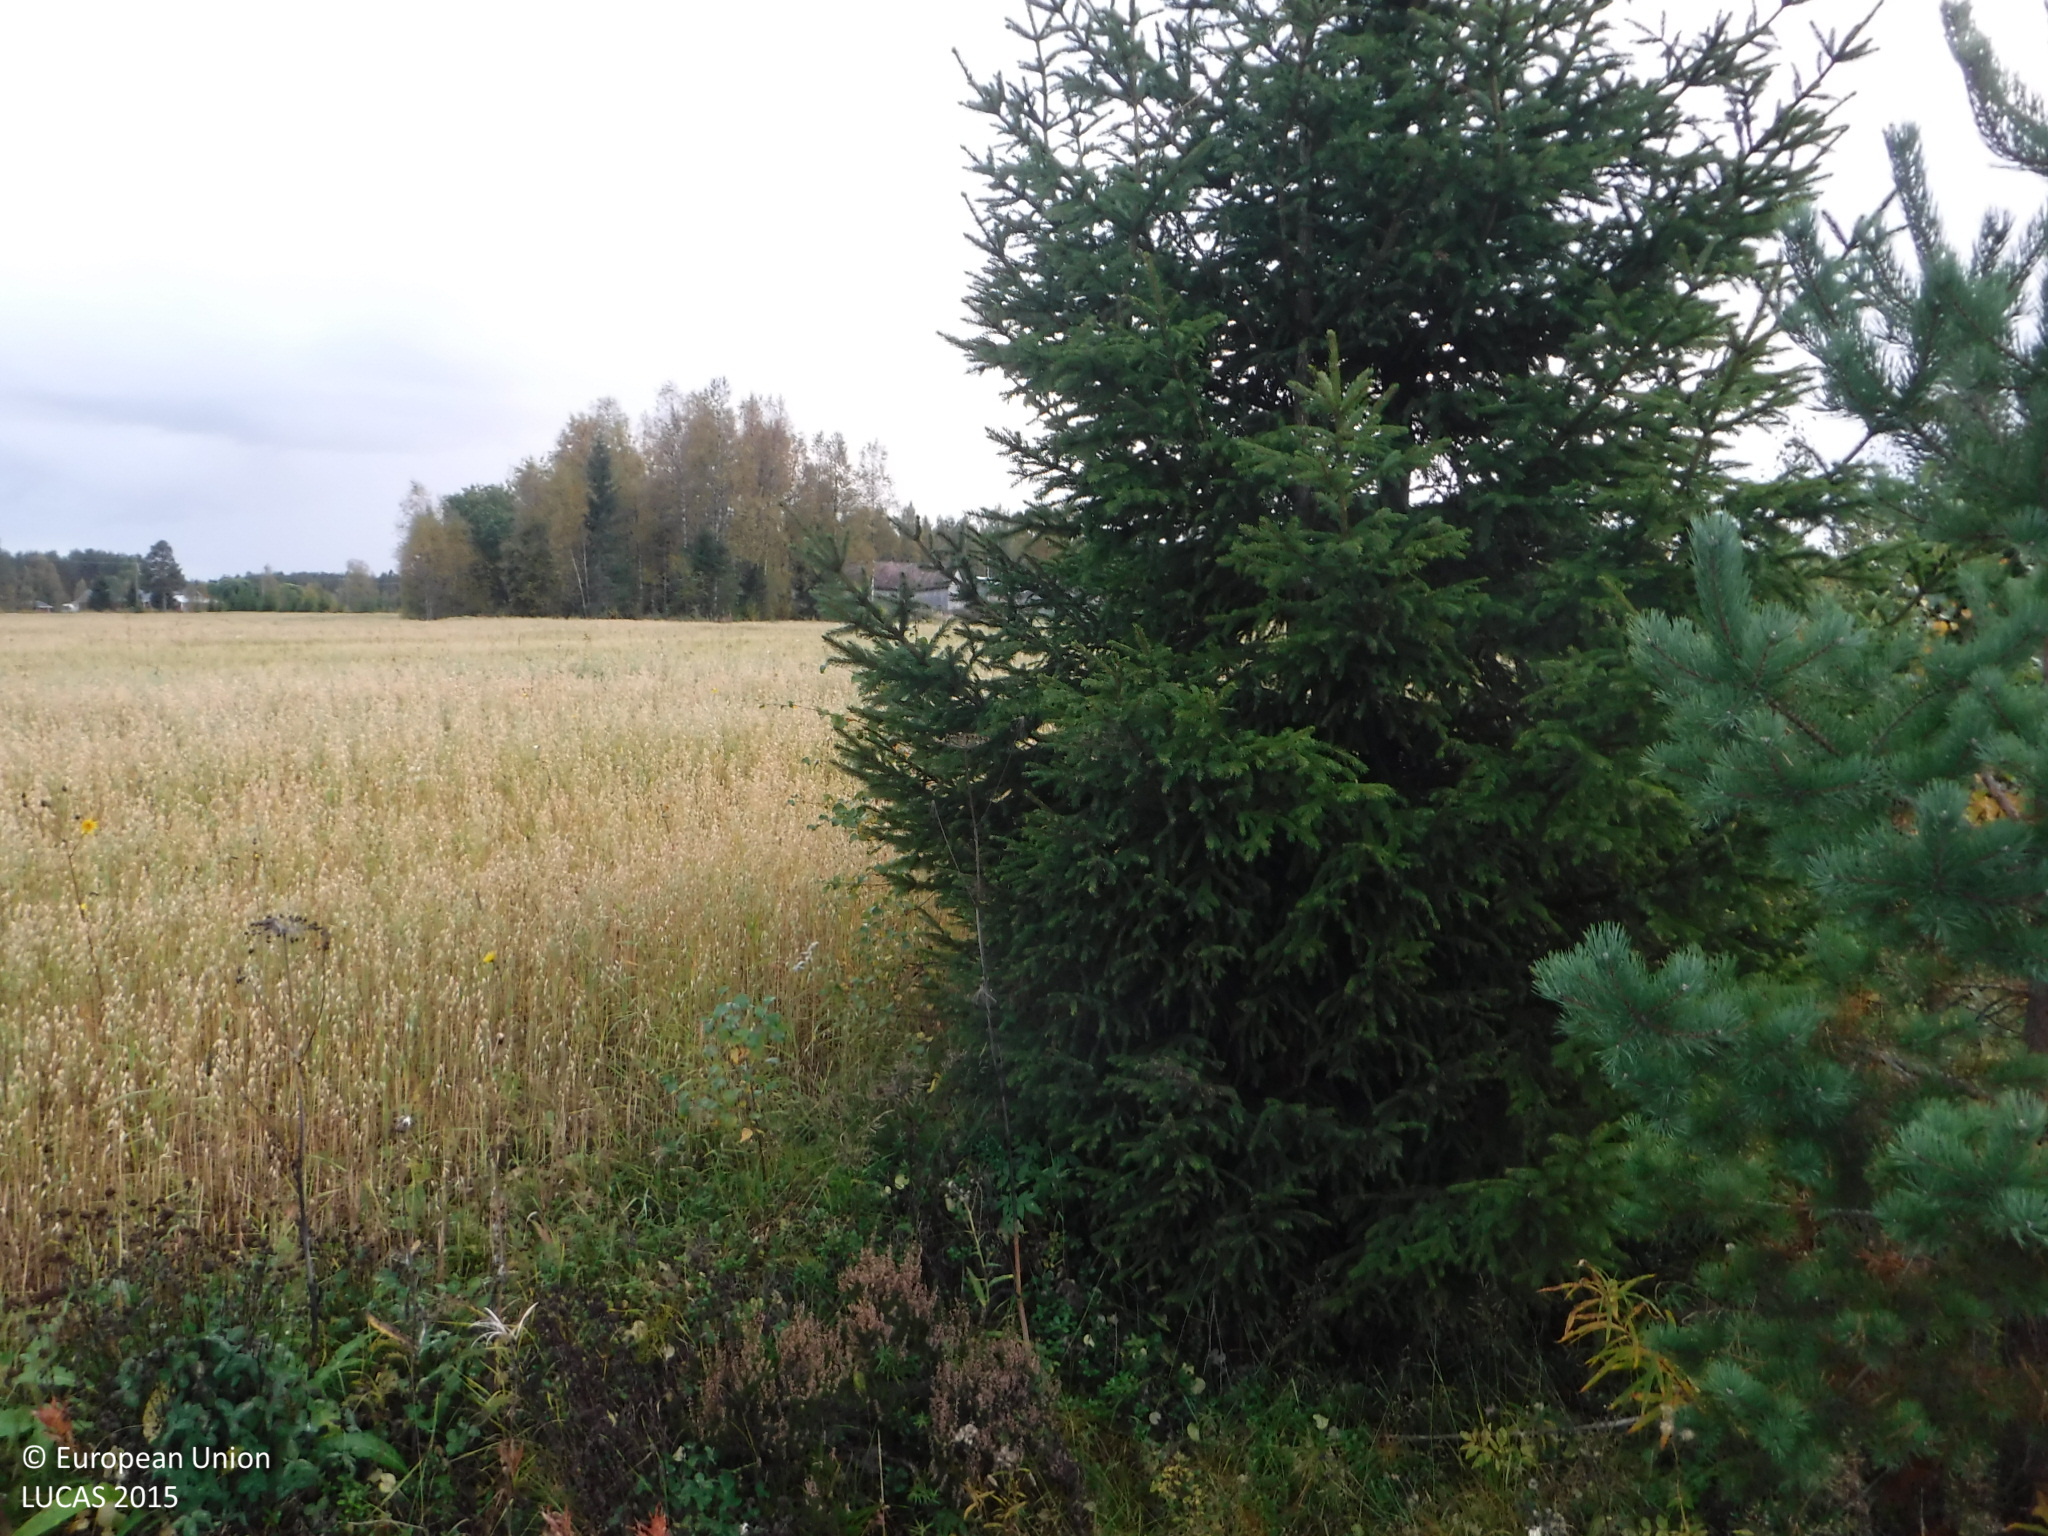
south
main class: Cropland
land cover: Oats
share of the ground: 50 - 75 %
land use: Agriculture (excluding fallow land and kitchen gardens)
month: September
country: FI
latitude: 62.0516
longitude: 22.5105
